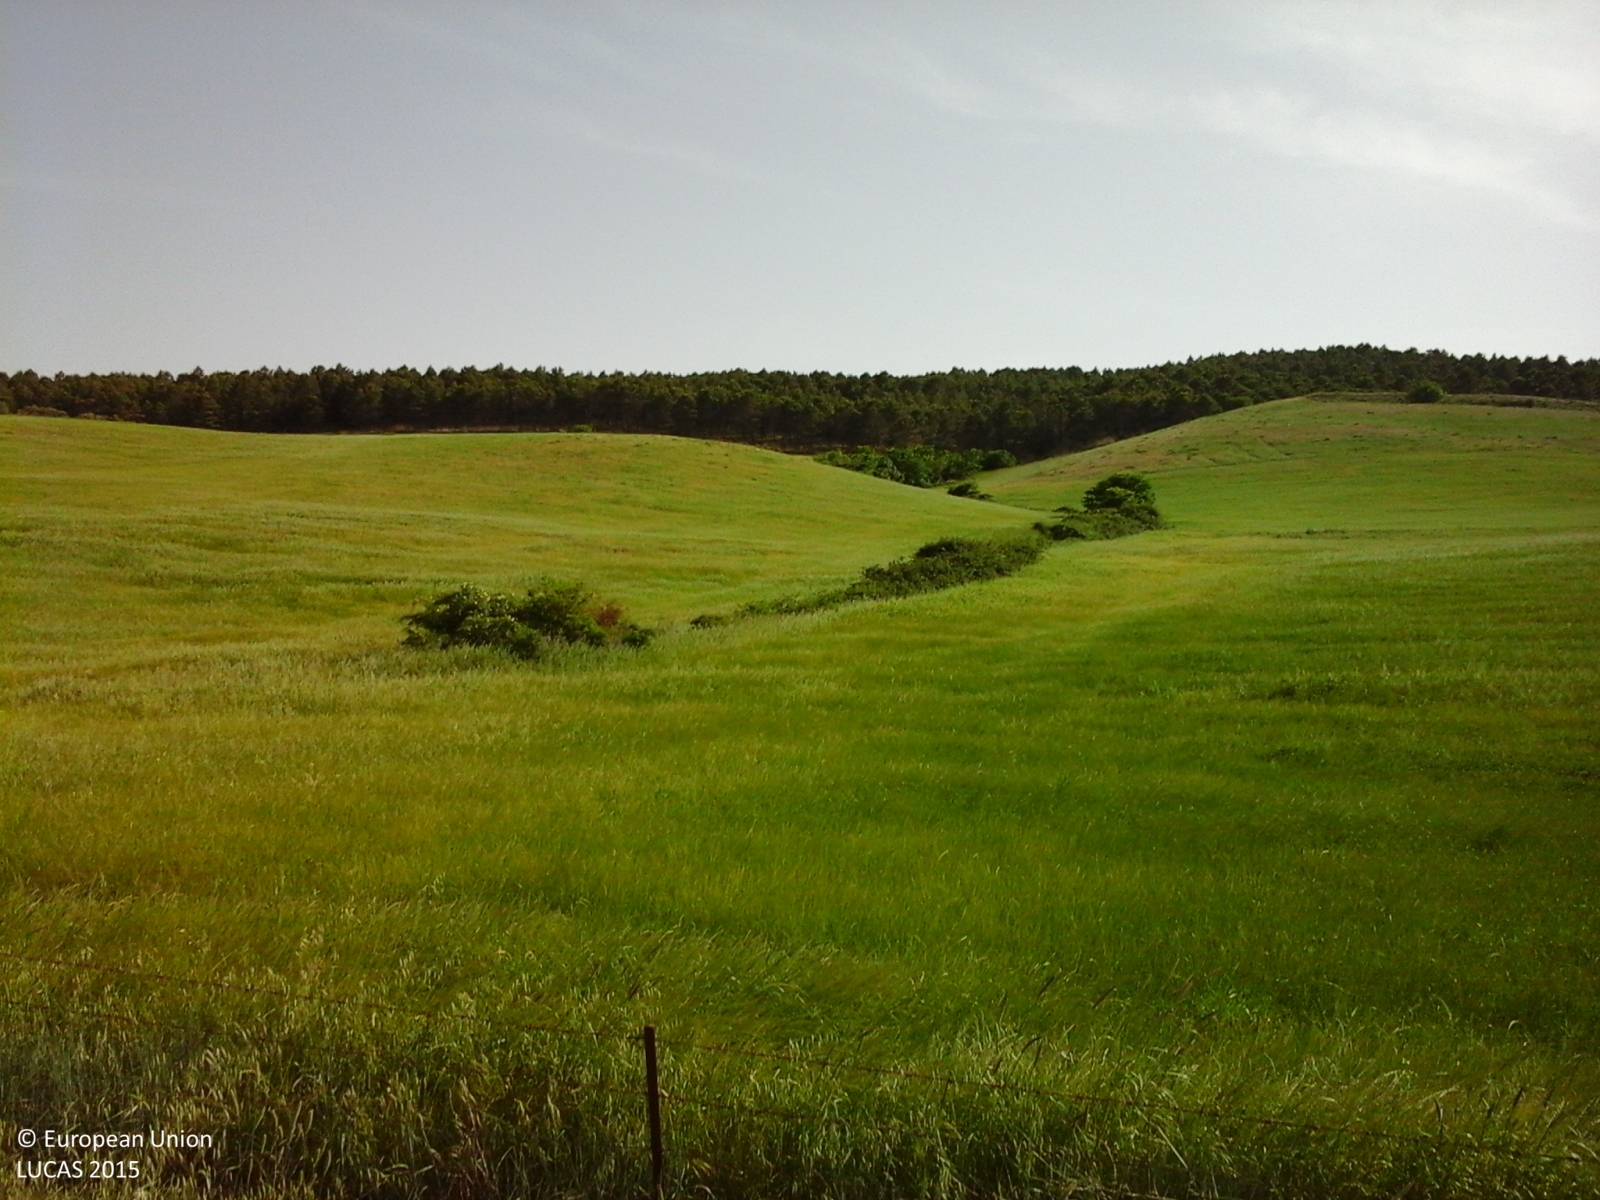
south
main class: Cropland
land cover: Mixed cereals for fodder
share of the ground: > 75 %
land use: Agriculture (excluding fallow land and kitchen gardens)
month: May
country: IT
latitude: 37.6452
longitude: 13.5437
